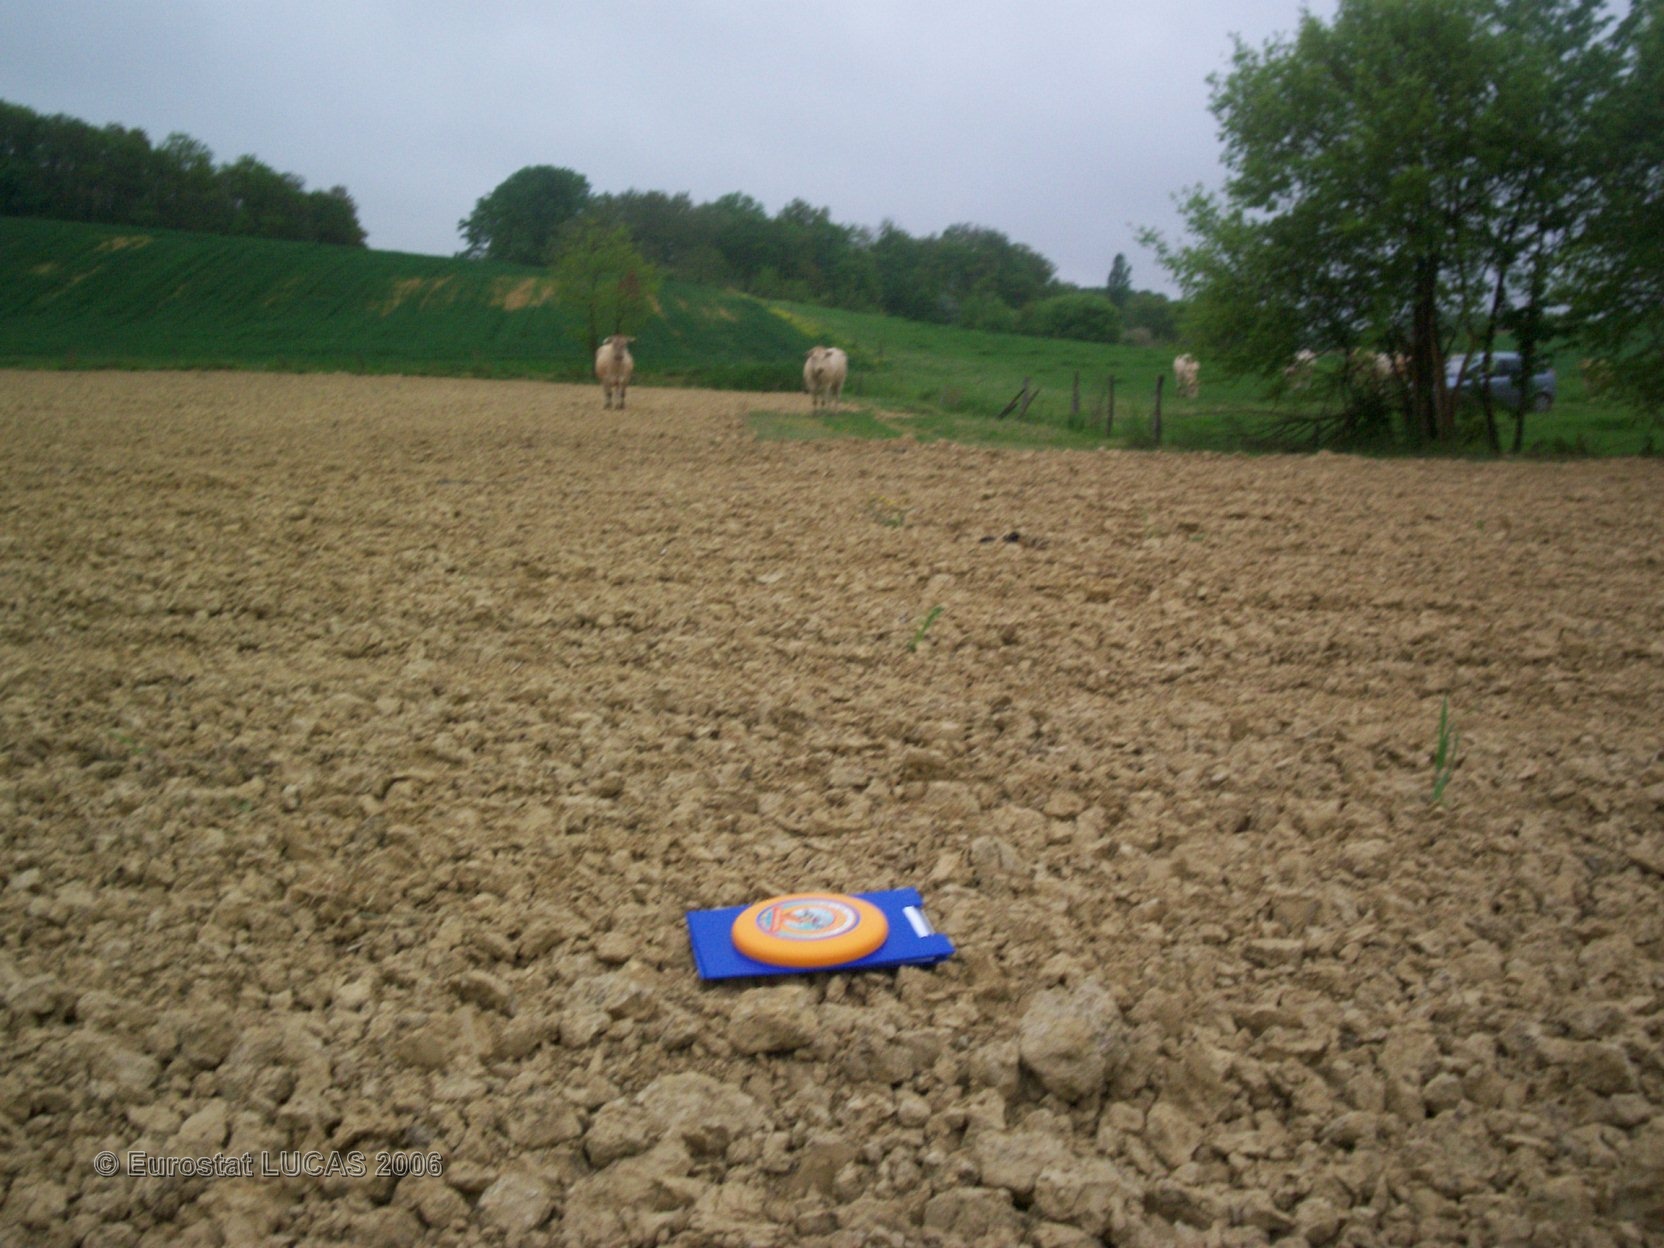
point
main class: Cropland
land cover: Maize
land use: Agriculture (excluding fallow land and kitchen gardens)
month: June
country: FR
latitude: 43.5774
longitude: -0.3486
